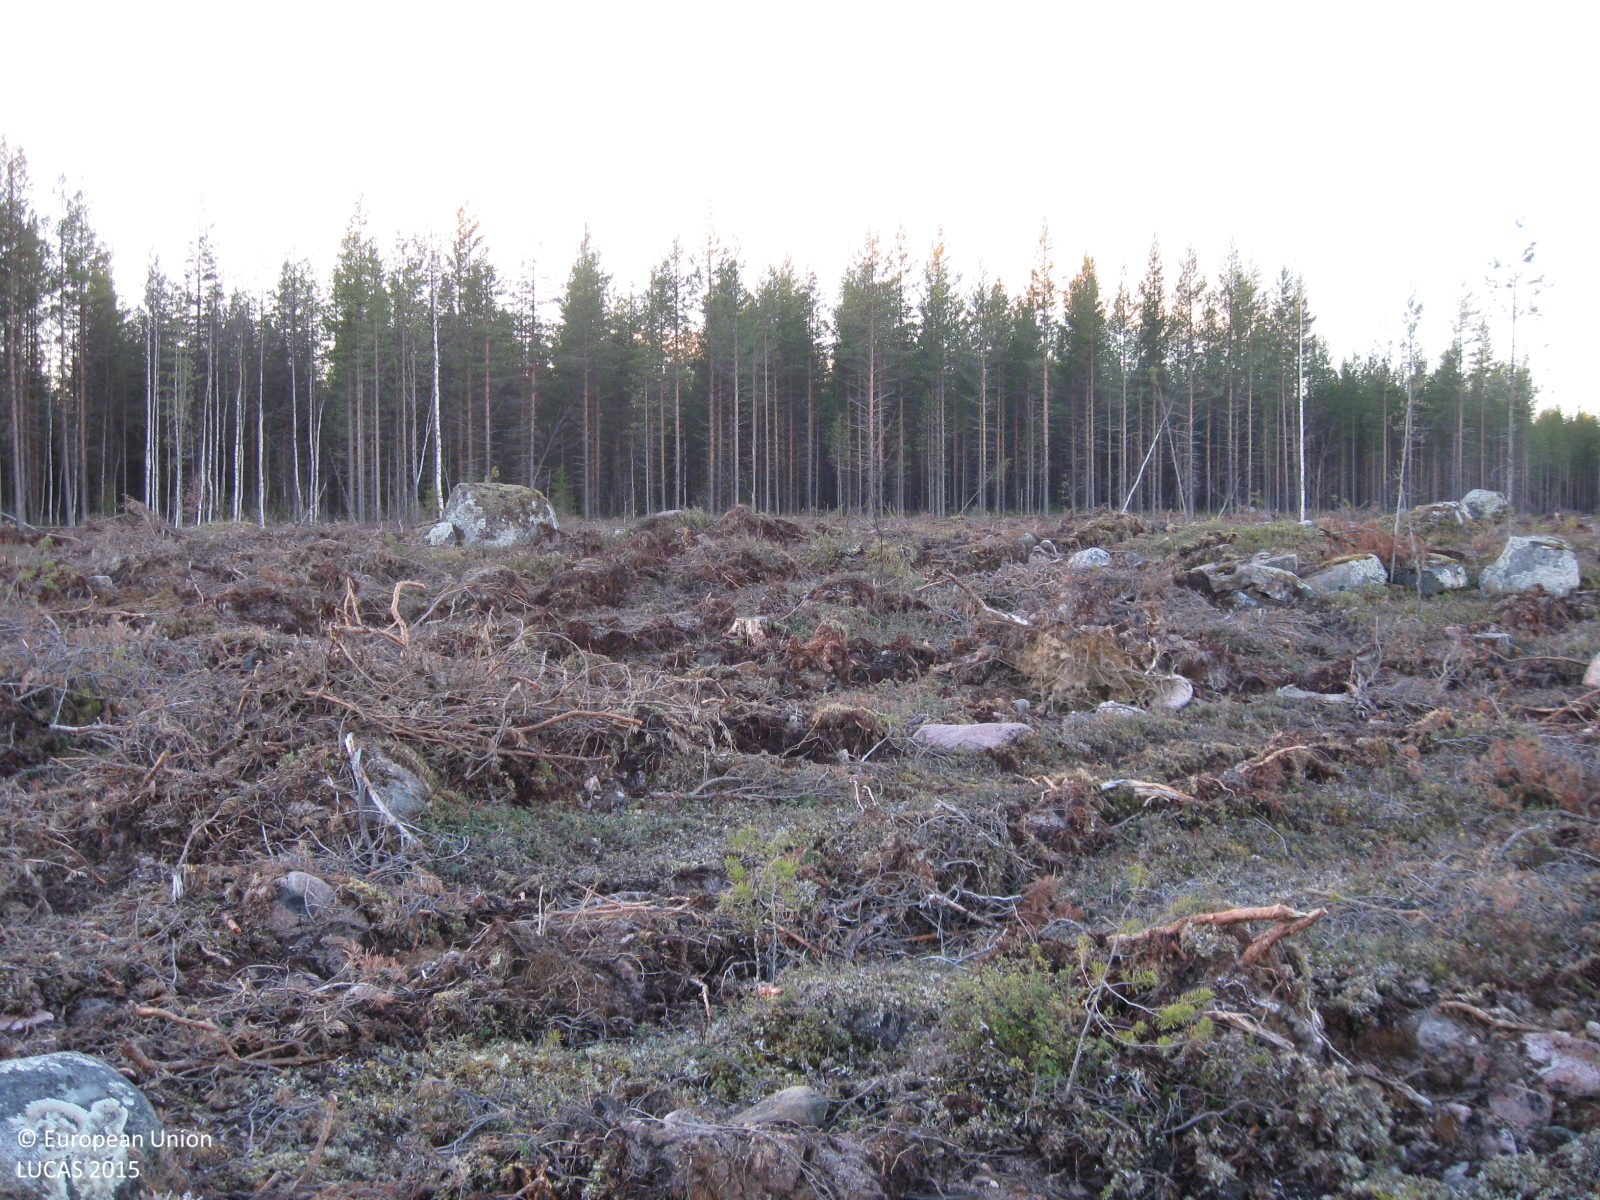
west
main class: Shrubland
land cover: Shrubland with sparse tree cover
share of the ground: 25 - 50 %
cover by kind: shrubs 30 %, unconsolidated bare surface 20 %, consolidated bare surface 15 %, herbaceous plants 10 %, lichens and mosses 10 %, coniferous forest trees 5 %
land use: Forestry
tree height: < 5 m
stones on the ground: > 50 %
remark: Clear cut
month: November
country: SE
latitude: 66.0693
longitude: 20.8995
